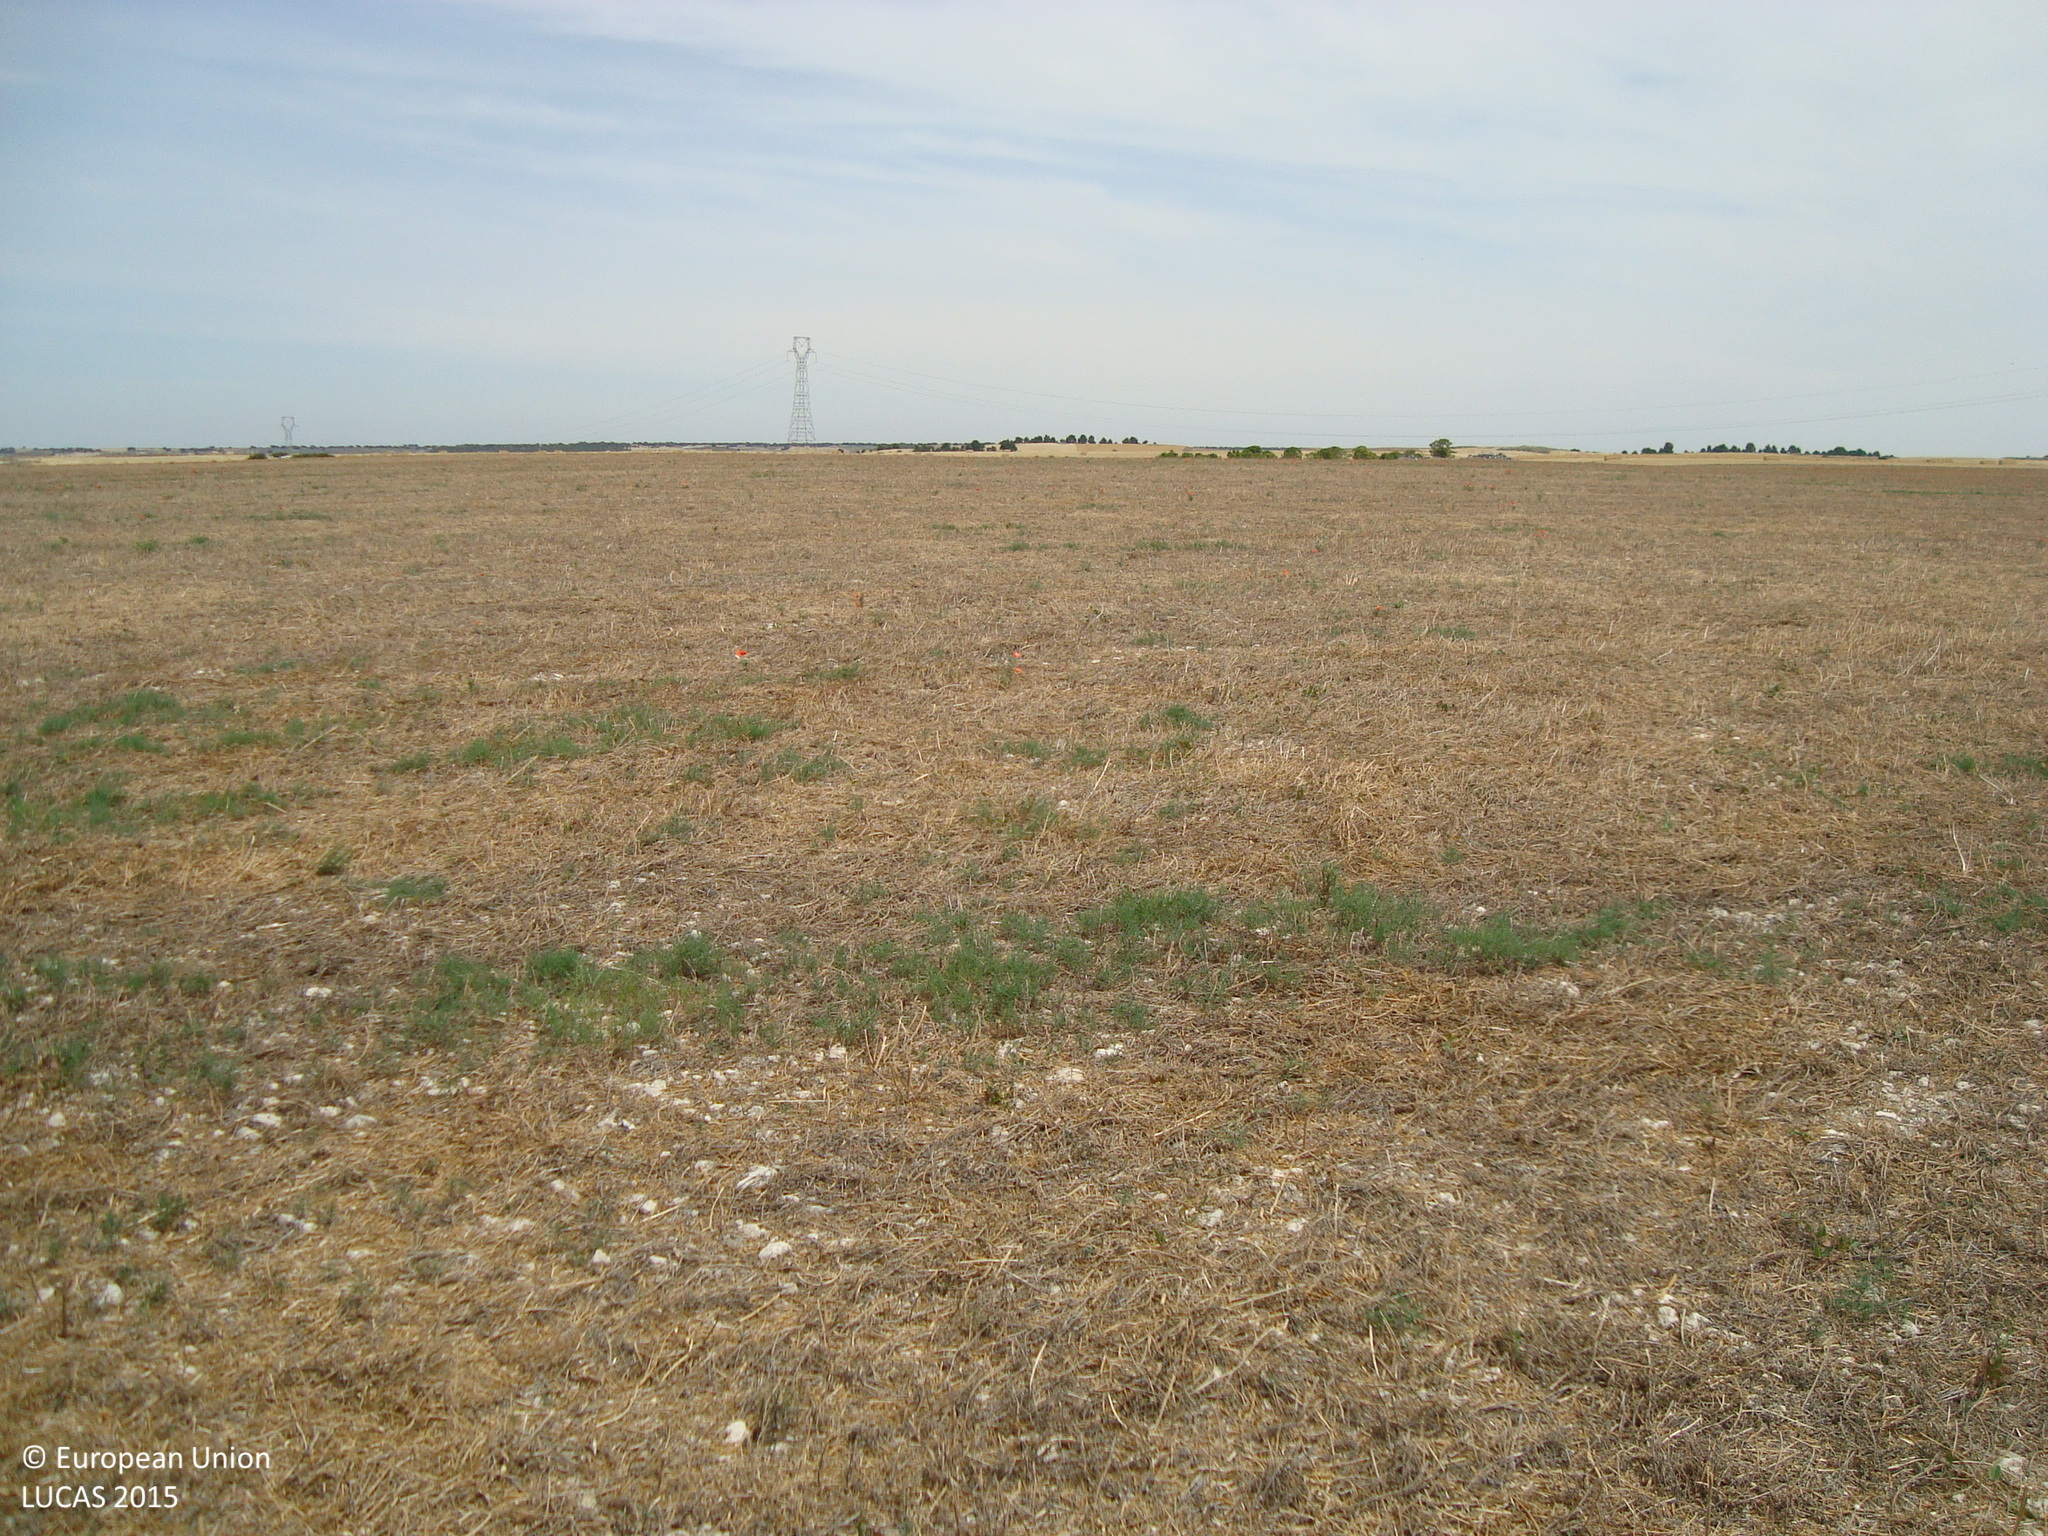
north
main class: Cropland
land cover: Dry pulses
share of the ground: < 10 %
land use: Agriculture (excluding fallow land and kitchen gardens)
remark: Harvested field
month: July
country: ES
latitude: 41.7408
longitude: -4.1896
